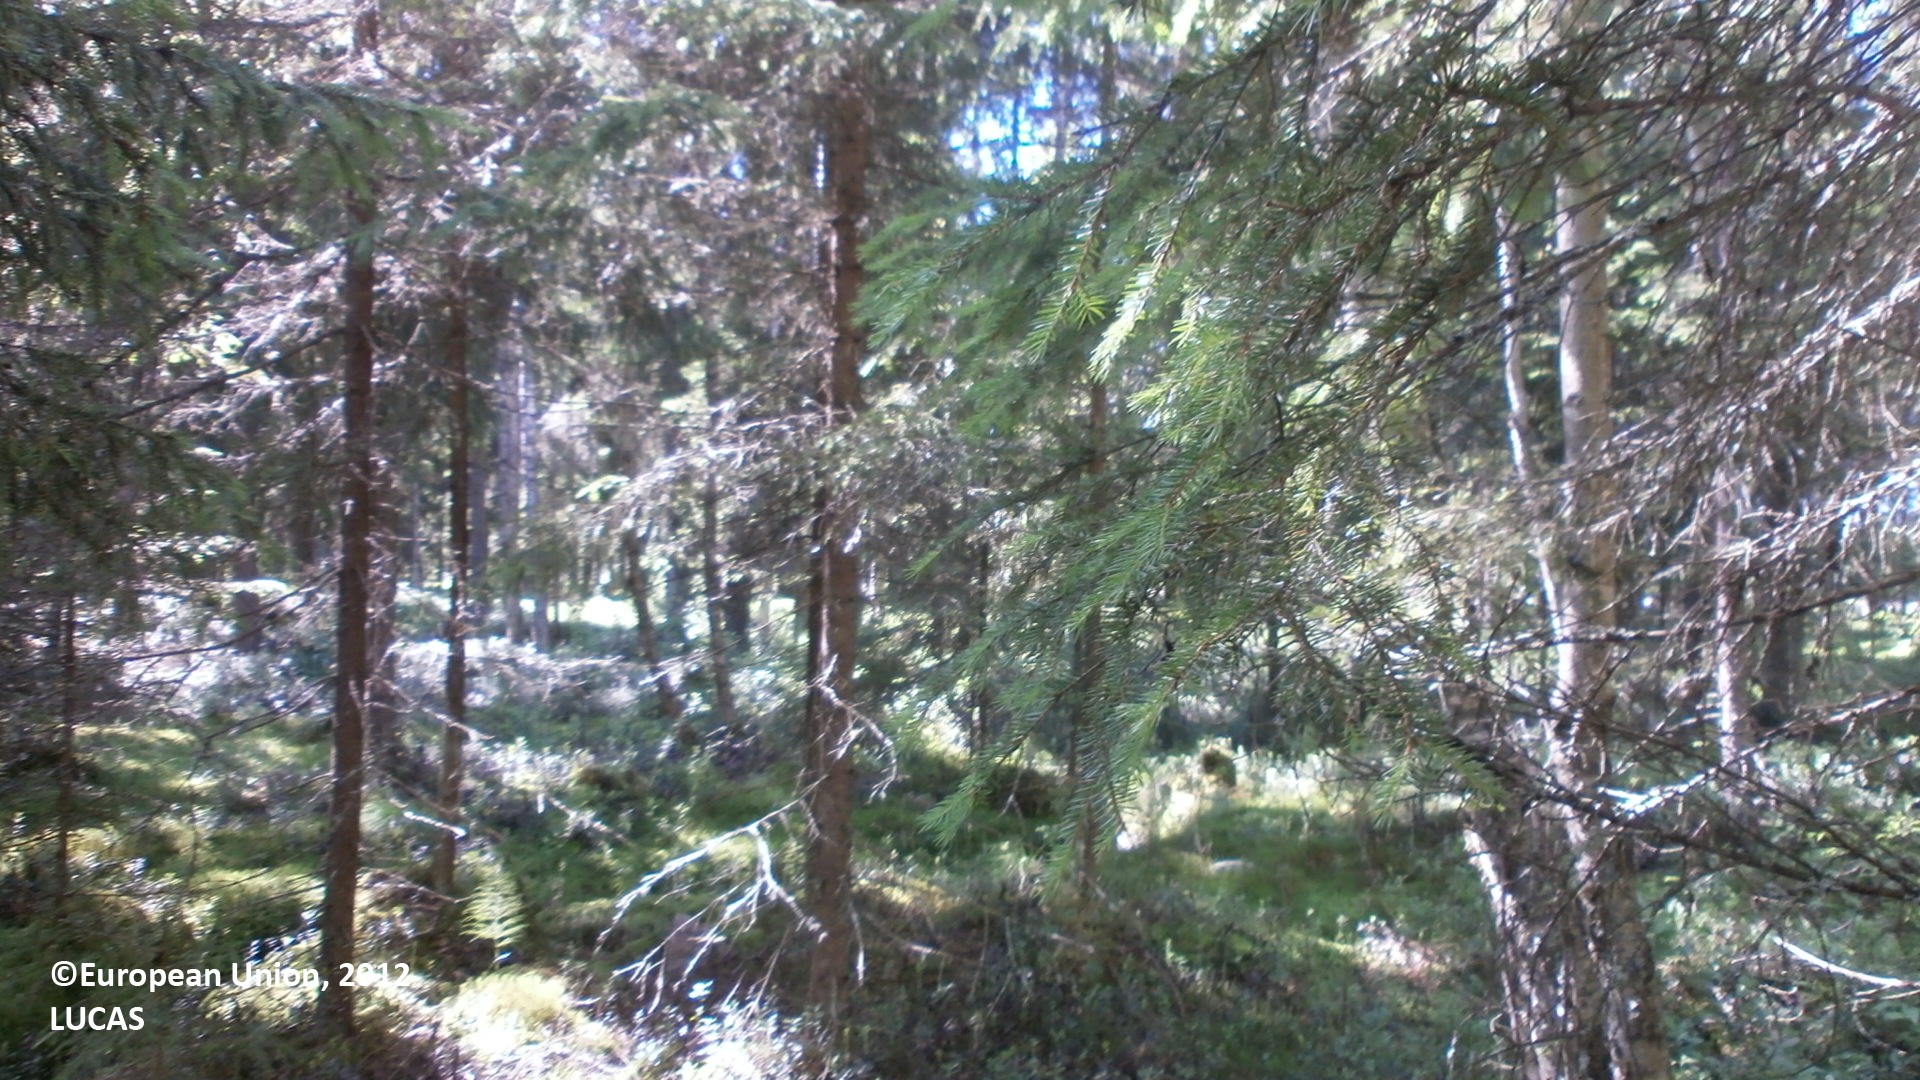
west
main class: Woodland
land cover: Spruce dominated coniferous woodland
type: boreal forest
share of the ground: > 75 %
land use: Forestry
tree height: > 5 m
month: July
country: FI
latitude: 64.3307
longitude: 23.9443
